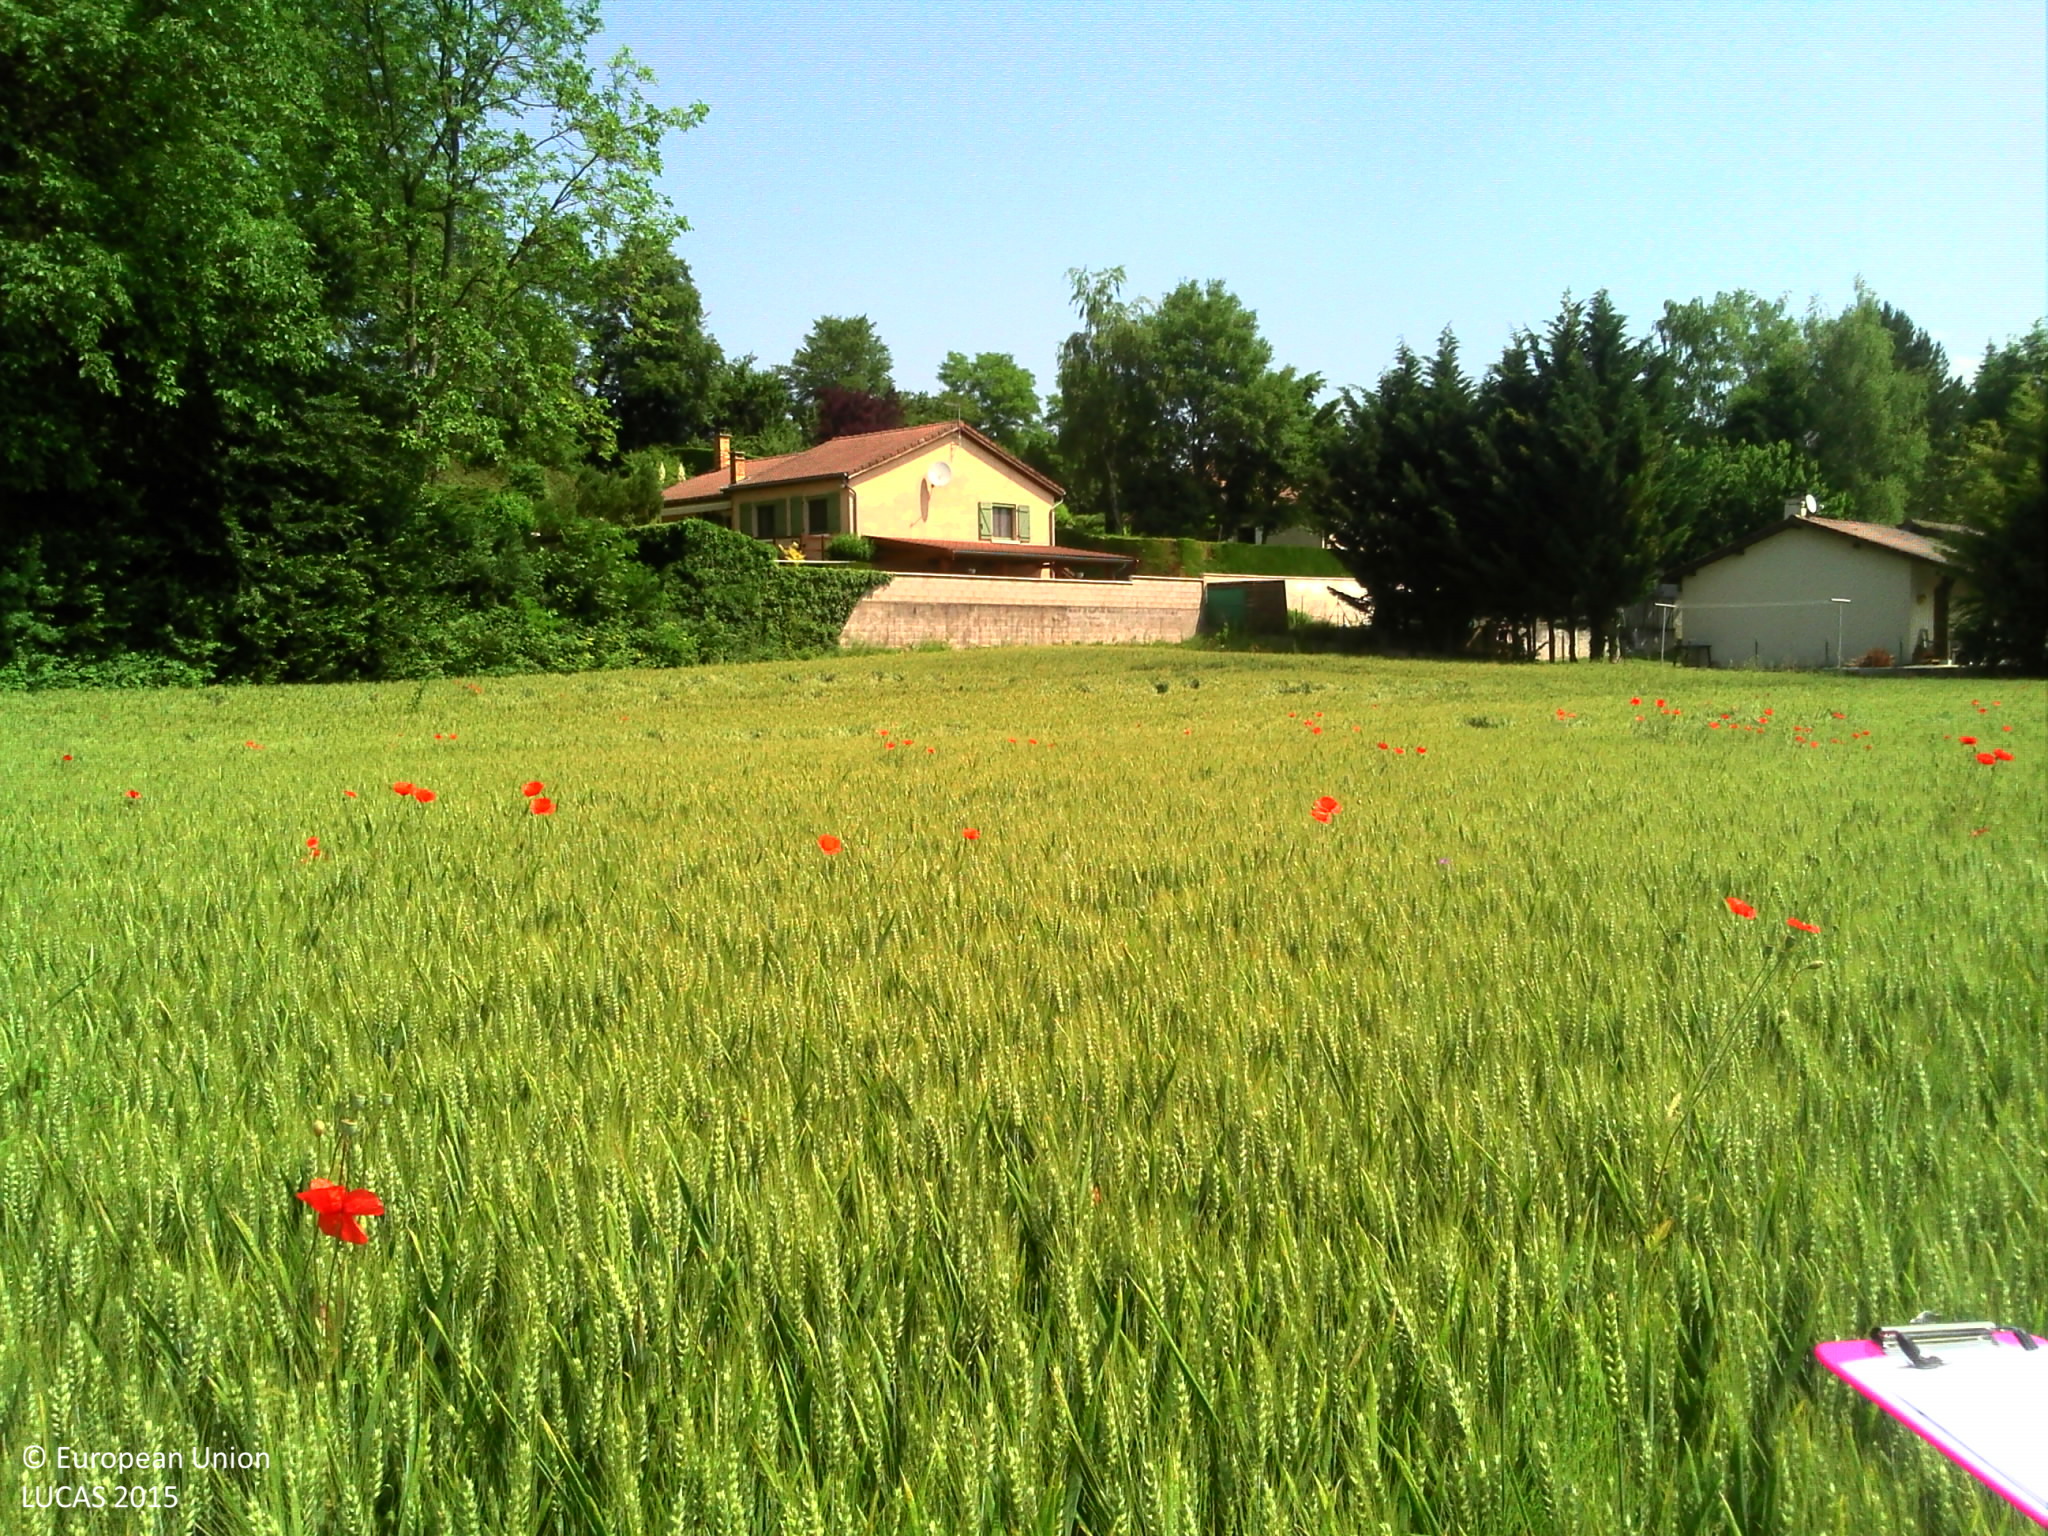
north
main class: Cropland
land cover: Durum wheat
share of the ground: > 75 %
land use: Agriculture (excluding fallow land and kitchen gardens)
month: June
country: FR
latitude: 45.8094
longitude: 5.1782
